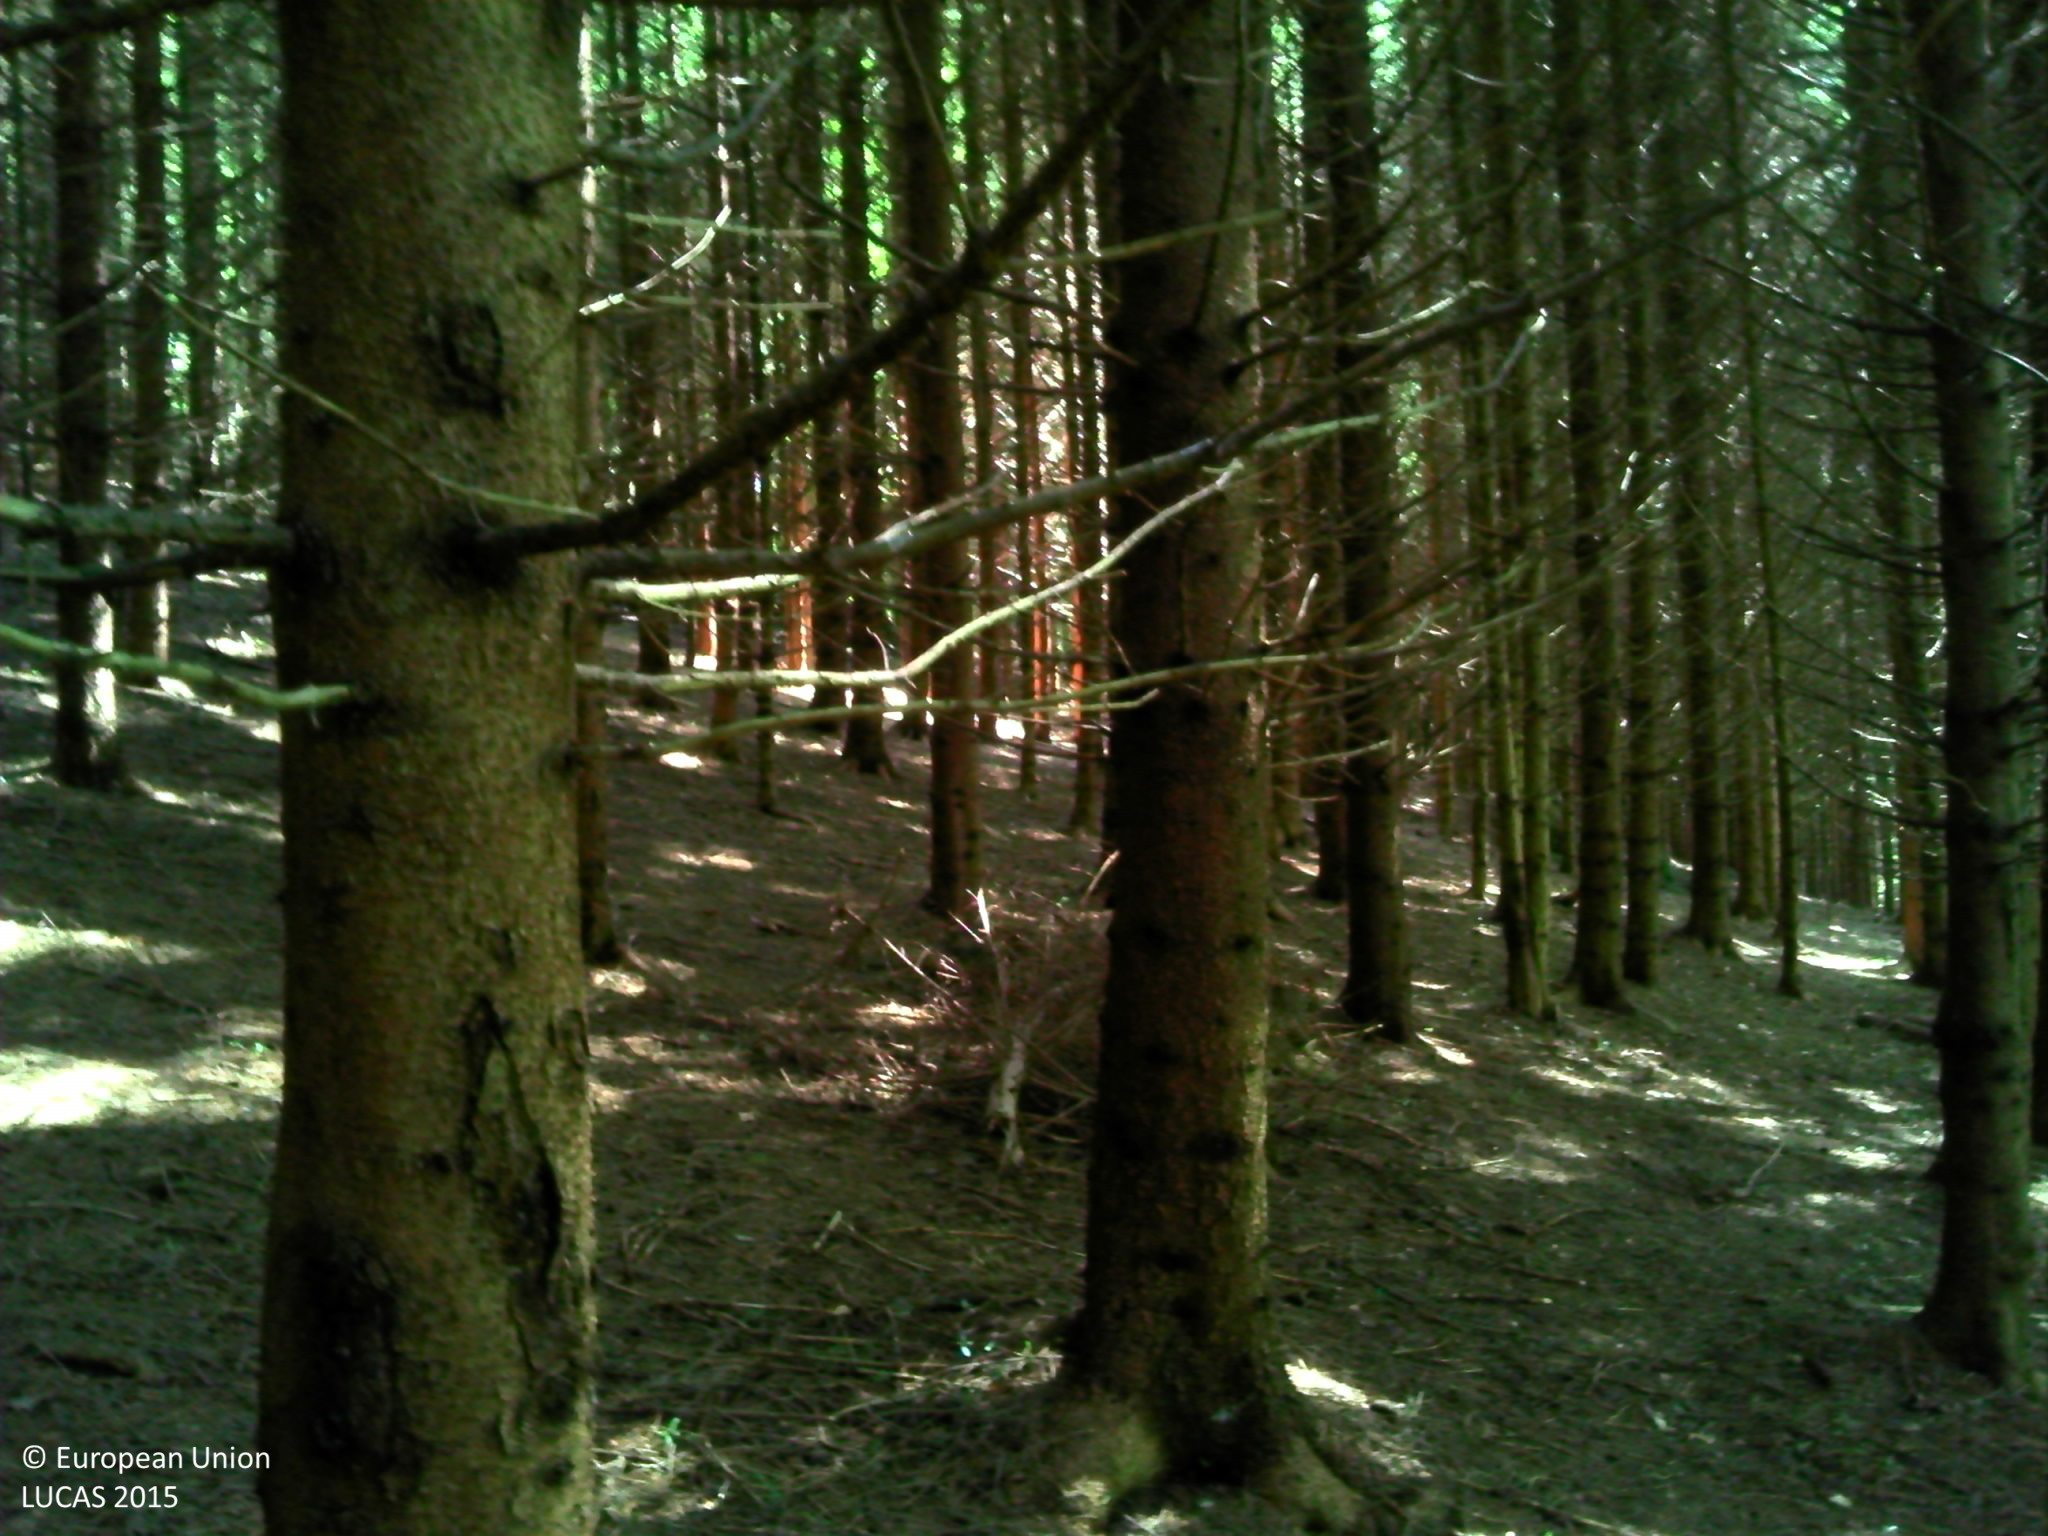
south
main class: Woodland
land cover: Spruce dominated coniferous woodland
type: alpine coniferous forest
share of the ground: > 75 %
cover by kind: coniferous forest trees 100 %
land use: Forestry
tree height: > 5 m
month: June
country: FR
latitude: 45.4894
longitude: 6.1789
